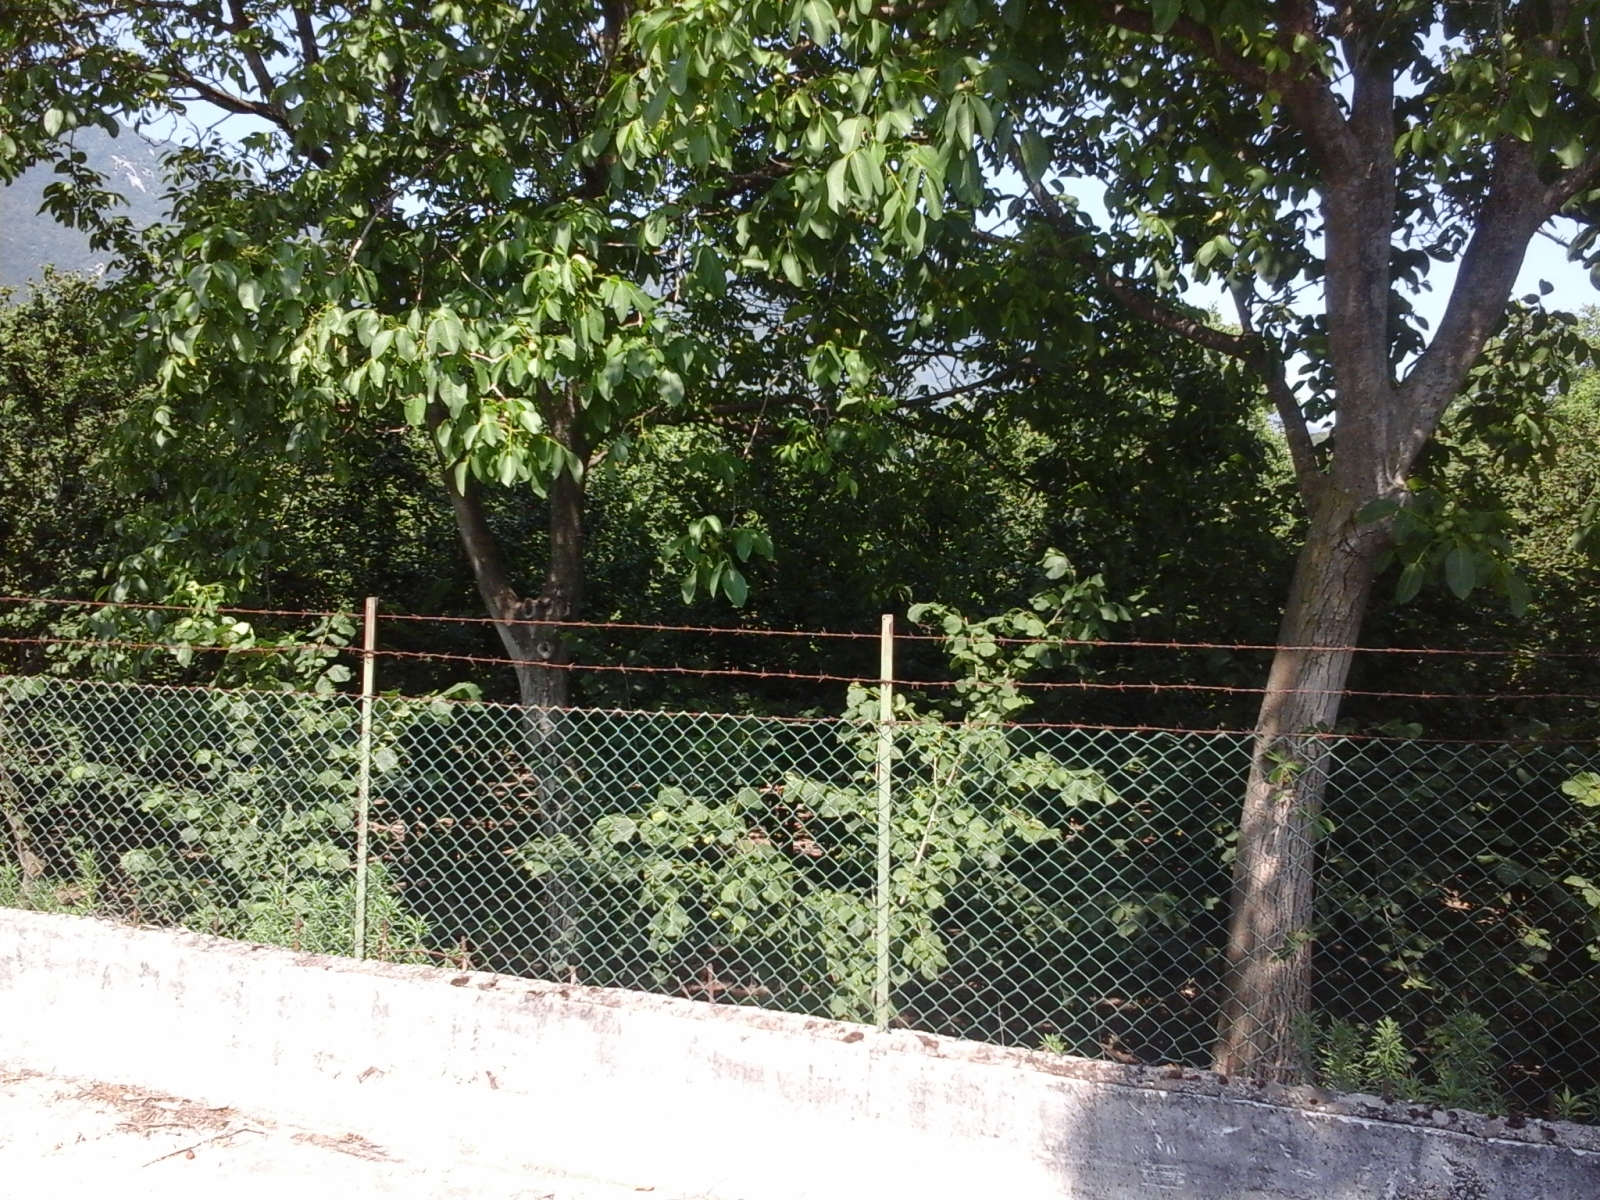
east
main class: Cropland
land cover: Nuts trees
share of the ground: > 75 %
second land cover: Other bare soil
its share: > 75 %
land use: Agriculture (excluding fallow land and kitchen gardens)
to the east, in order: Nuts trees; Other bare soil; Fences; Paved roads, cycling and walking lanes; Electric lines; Fences; Nuts trees; Arable land (only in case pi); Artificial constructions in urban areas
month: July
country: IT
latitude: 40.9746
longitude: 14.6045
